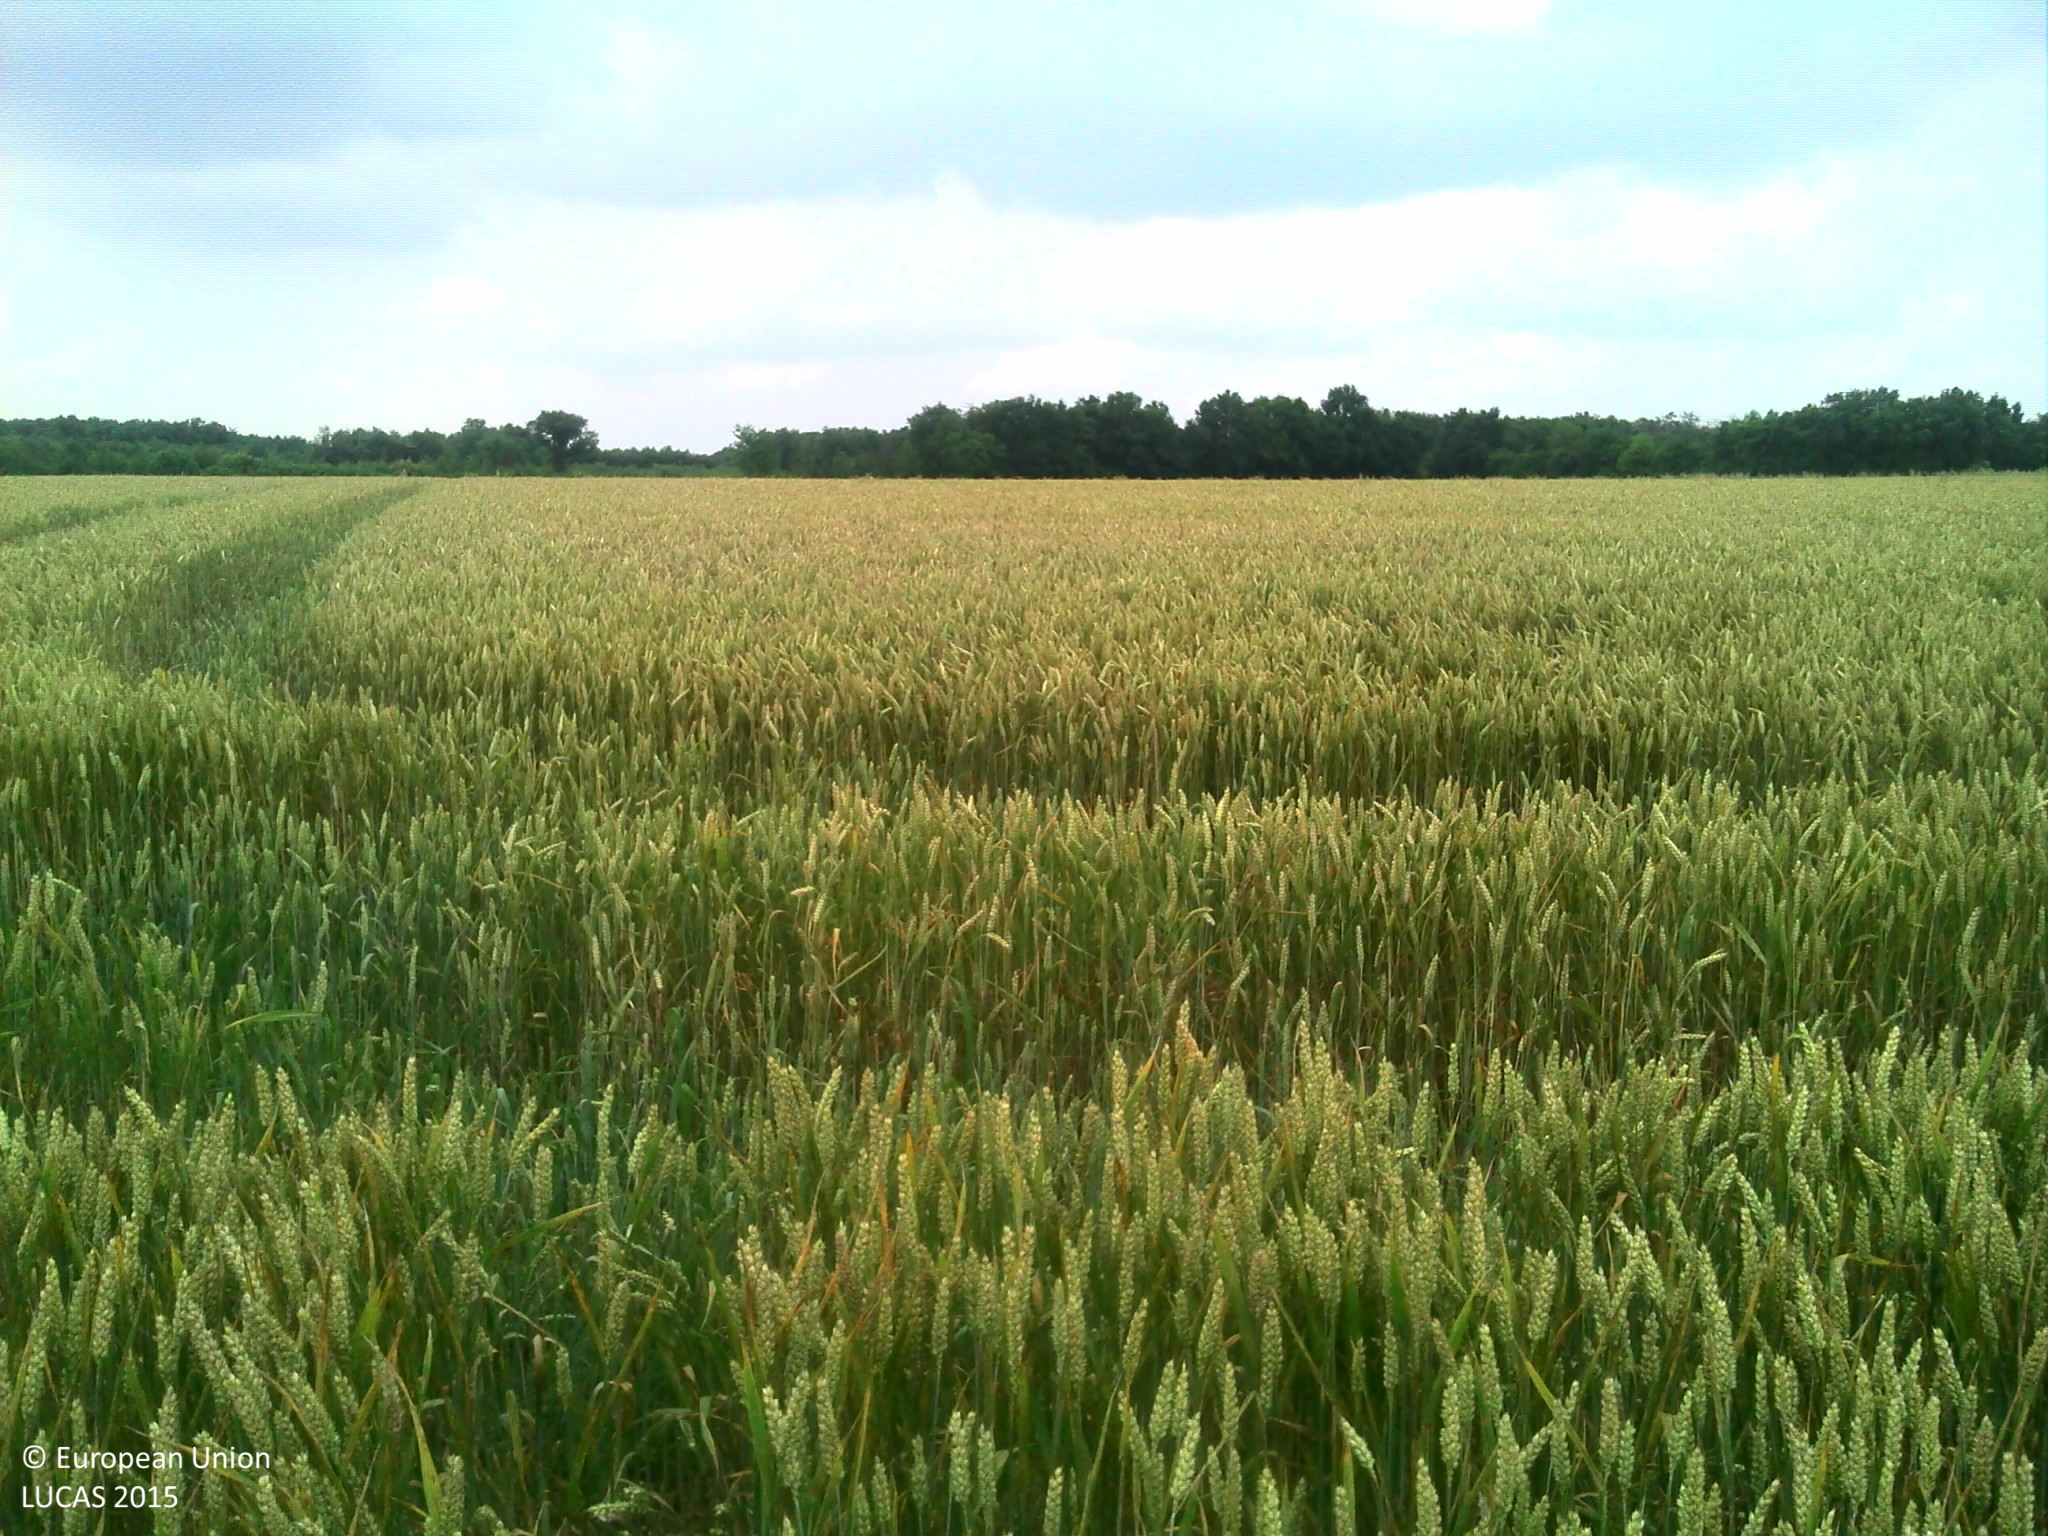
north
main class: Cropland
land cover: Common wheat
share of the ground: > 75 %
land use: Agriculture (excluding fallow land and kitchen gardens)
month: June
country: FR
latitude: 45.9051
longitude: -0.6859
